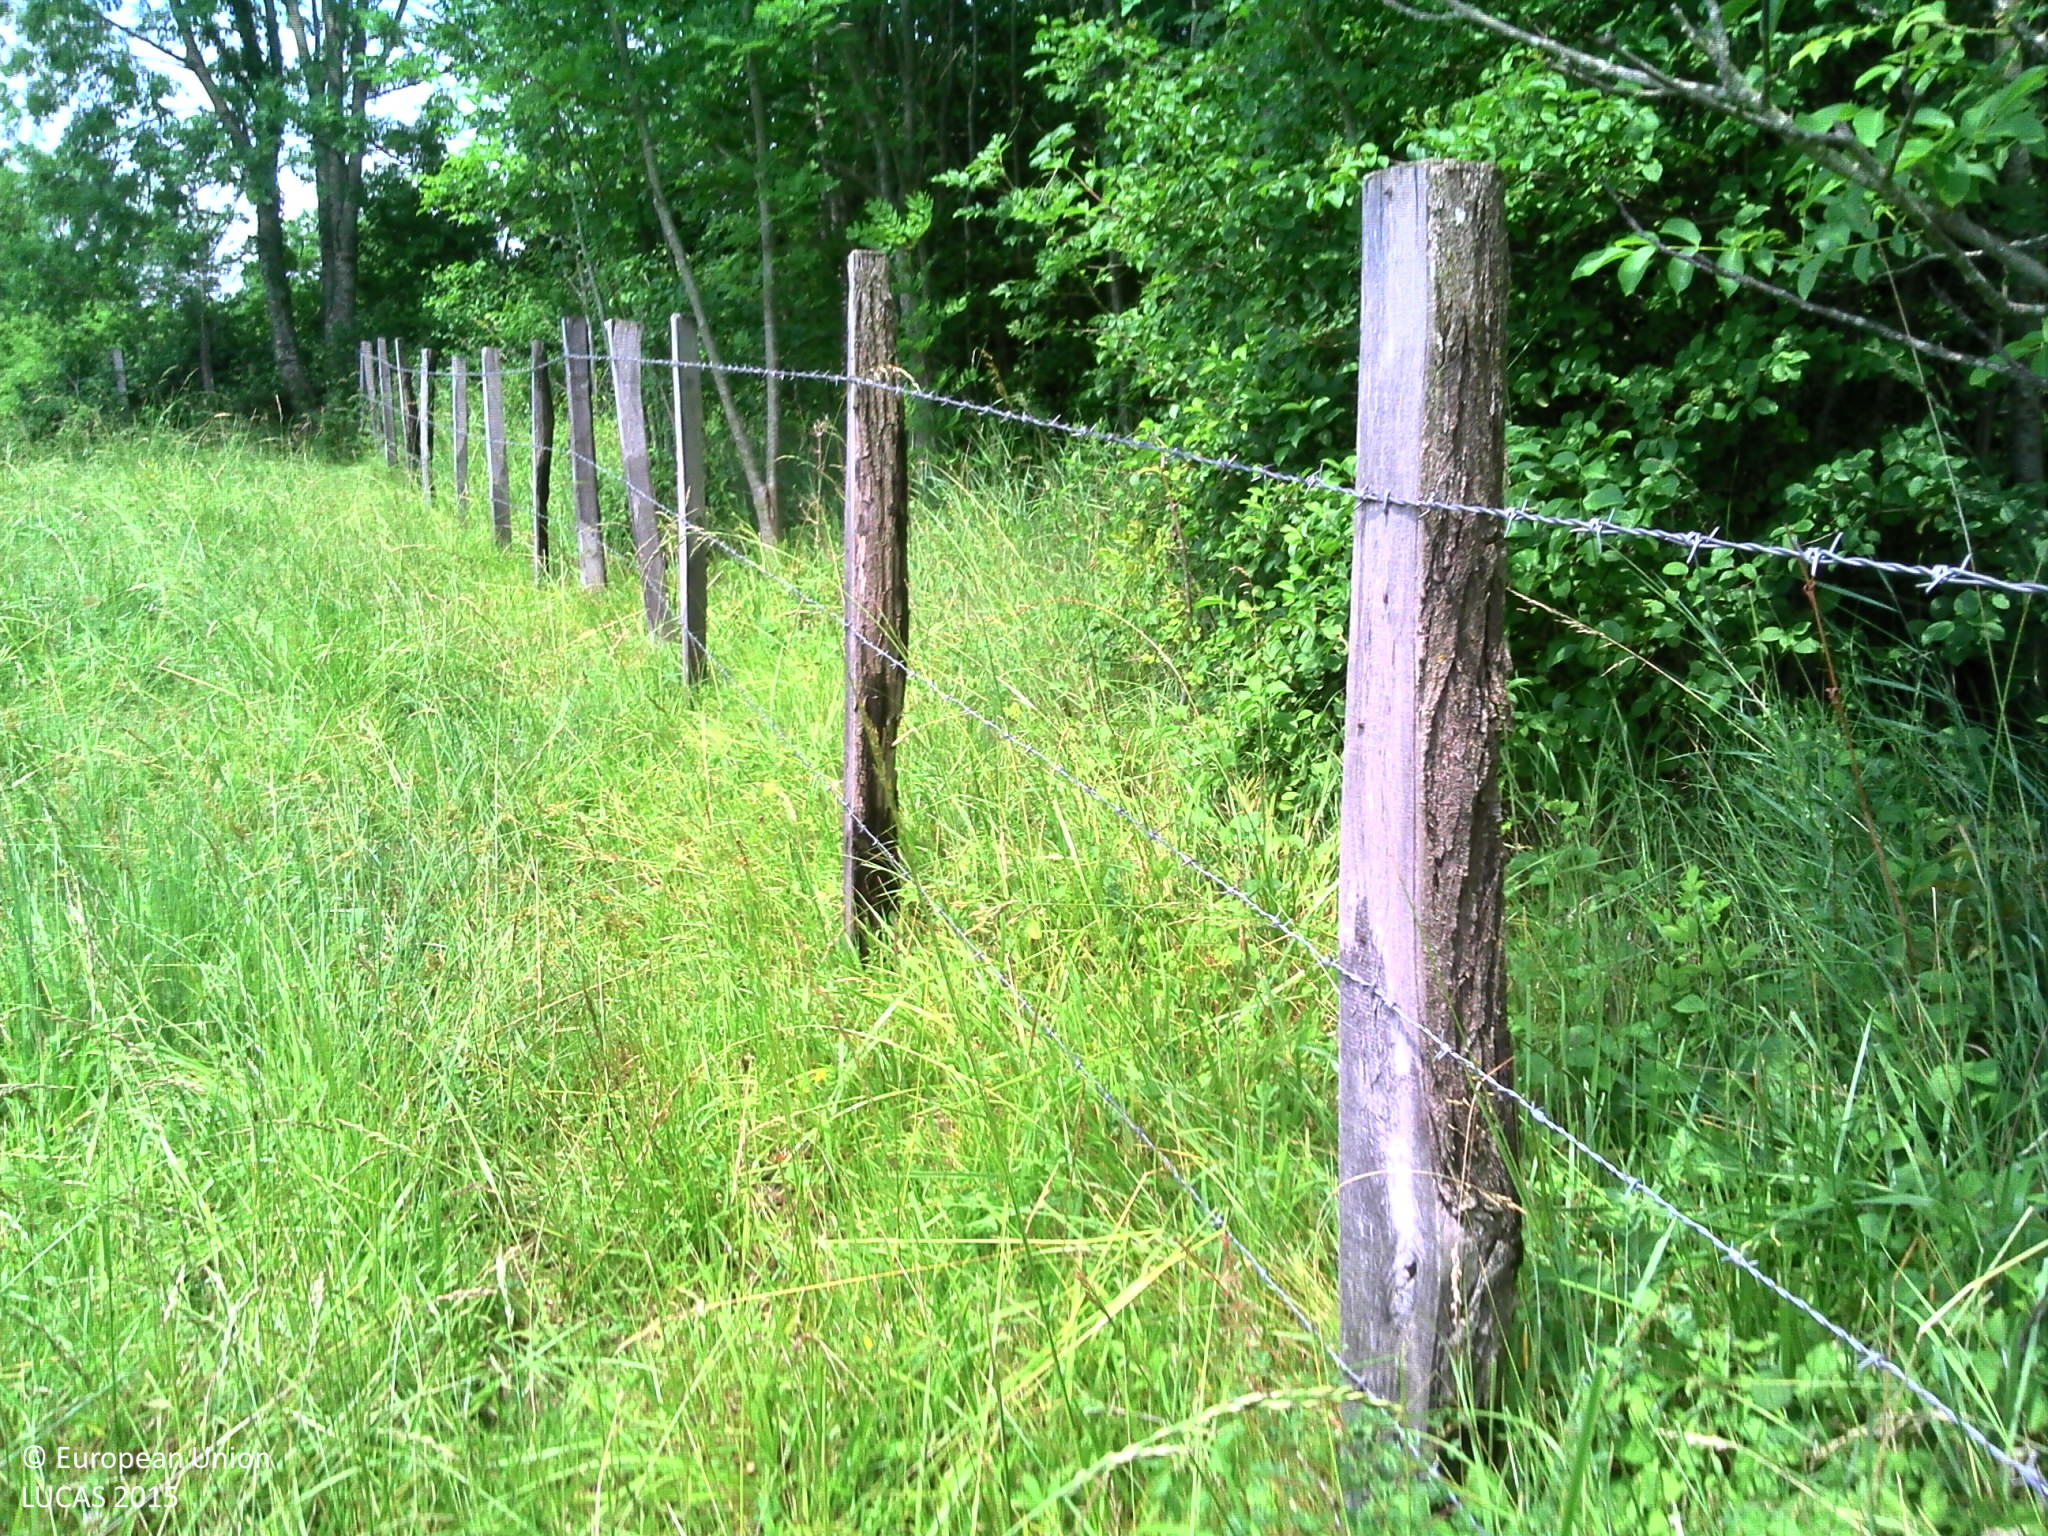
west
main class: Grassland
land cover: Grassland without tree/shrub cover
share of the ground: > 75 %
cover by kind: herbaceous plants 100 %
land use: Agriculture (excluding fallow land and kitchen gardens)
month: June
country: FR
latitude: 45.2606
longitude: 5.0221
